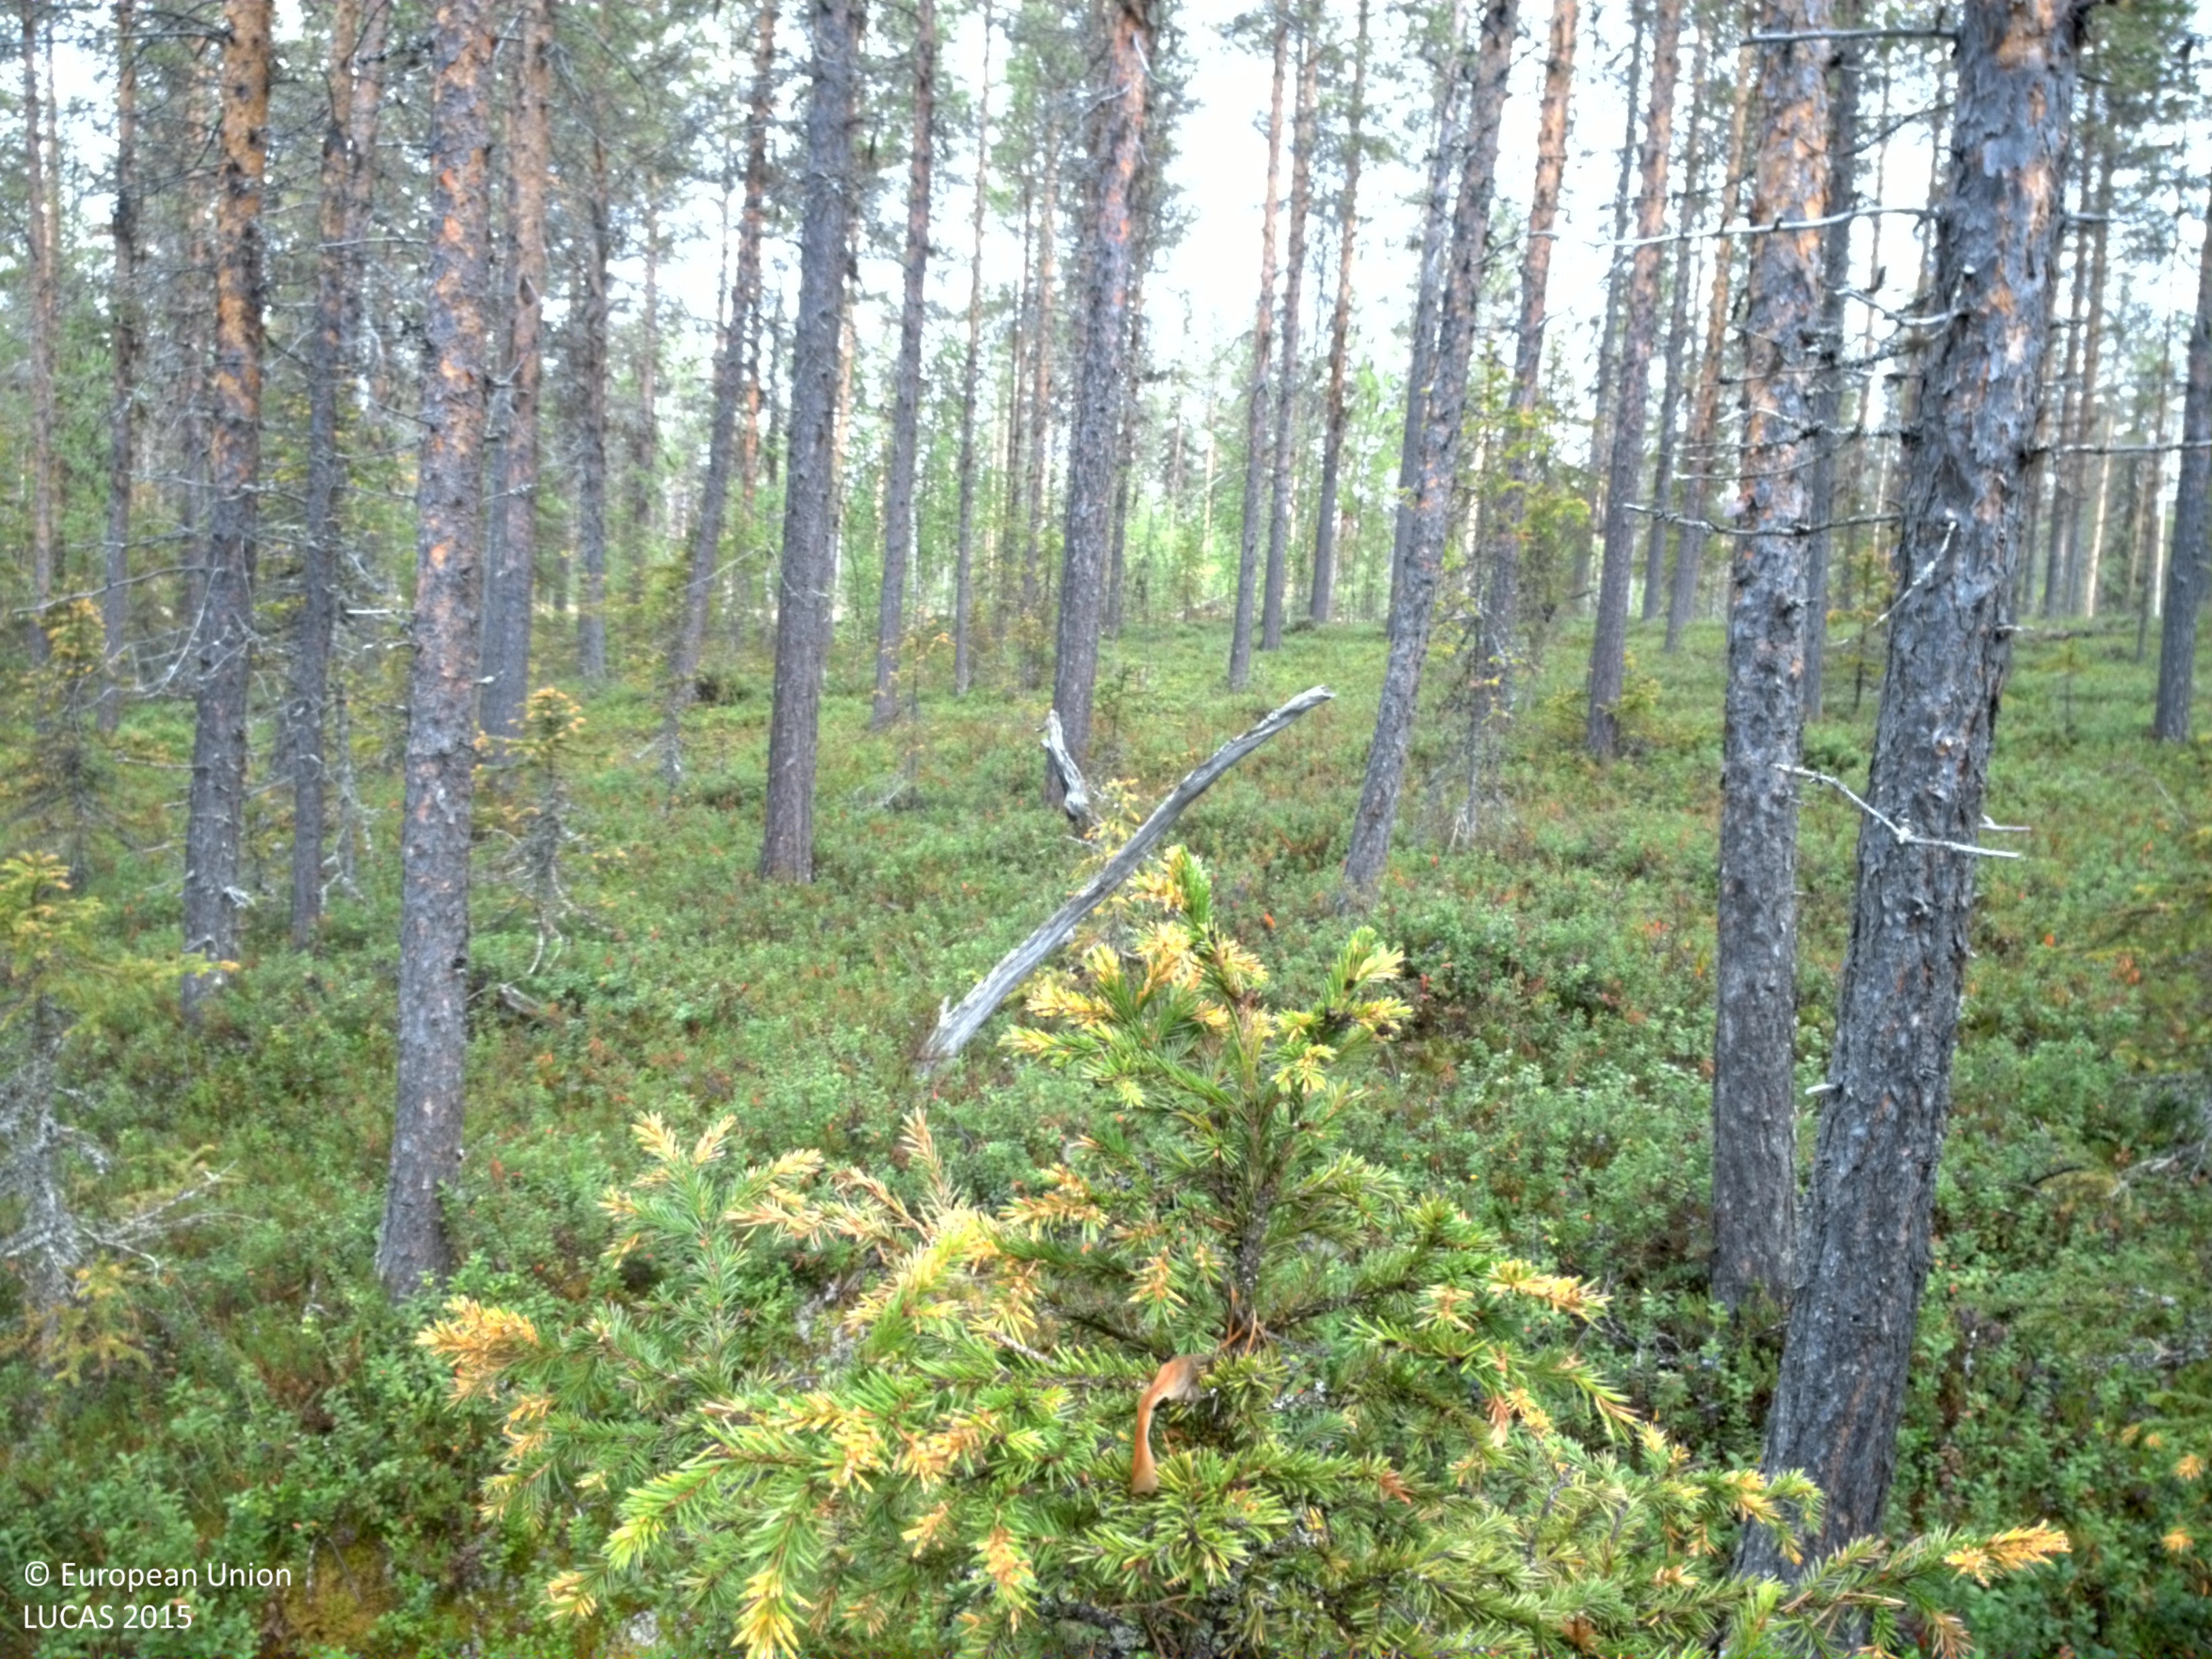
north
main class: Woodland
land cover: Pine dominated coniferous woodland
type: boreal forest
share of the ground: 25 - 50 %
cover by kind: shrubs 65 %, coniferous forest trees 30 %, broadleaved forest trees 5 %
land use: Forestry
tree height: > 5 m
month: August
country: SE
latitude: 66.5855
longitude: 19.6264
